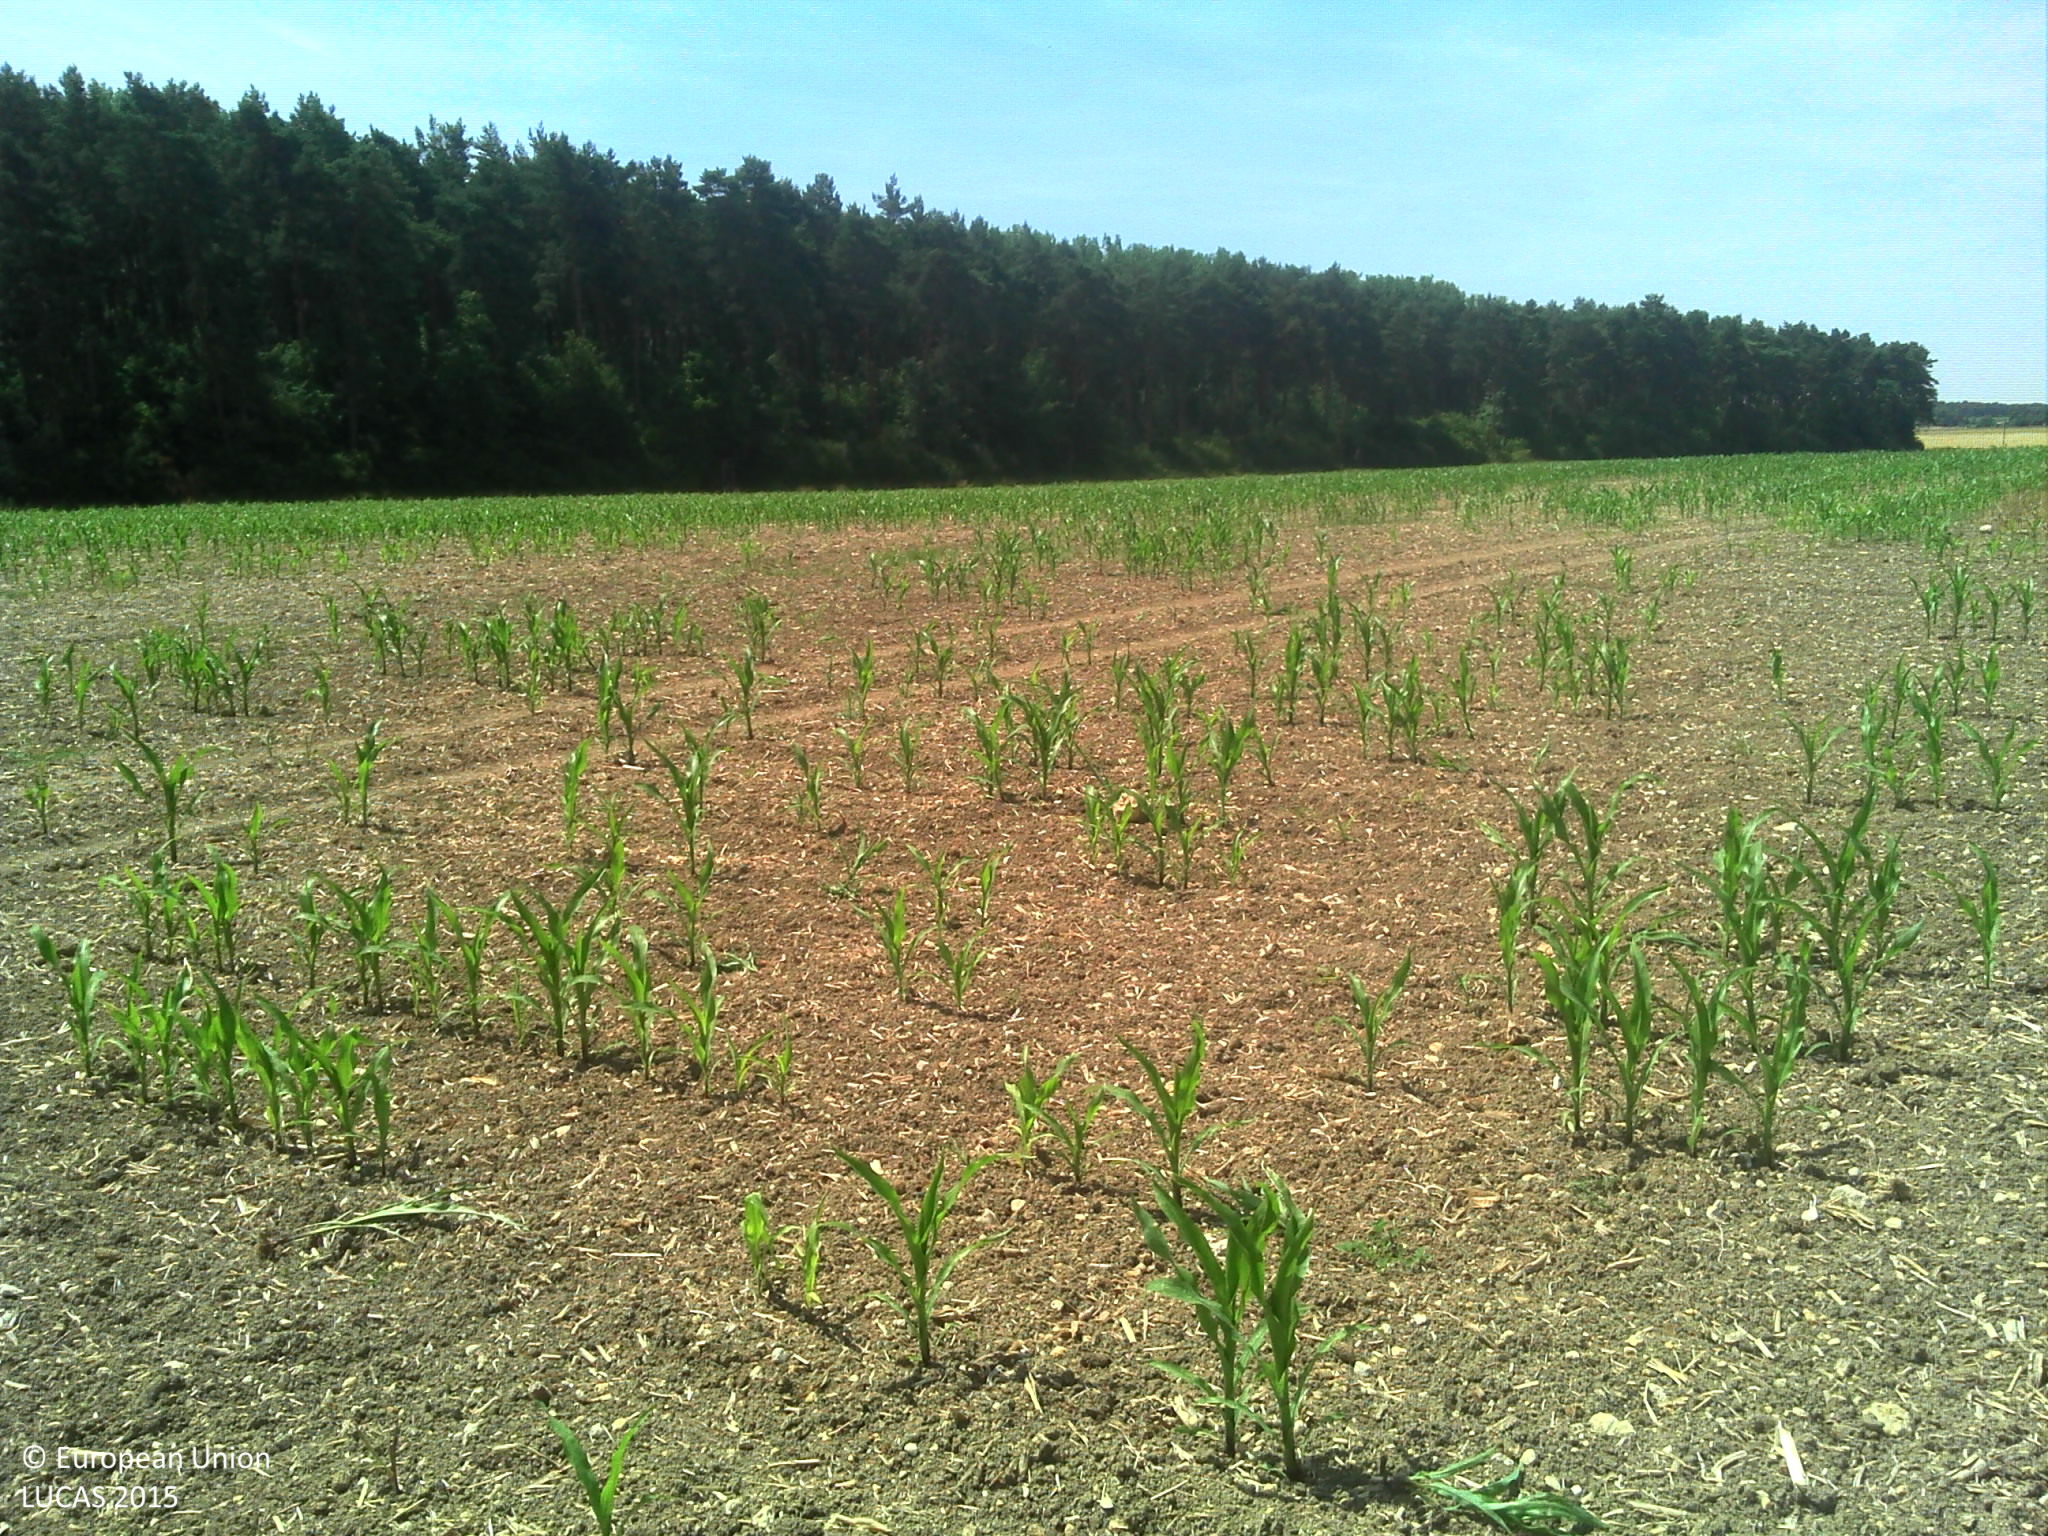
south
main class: Cropland
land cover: Maize
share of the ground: 10 - 25 %
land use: Agriculture (excluding fallow land and kitchen gardens)
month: June
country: FR
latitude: 47.4866
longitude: 1.3719
